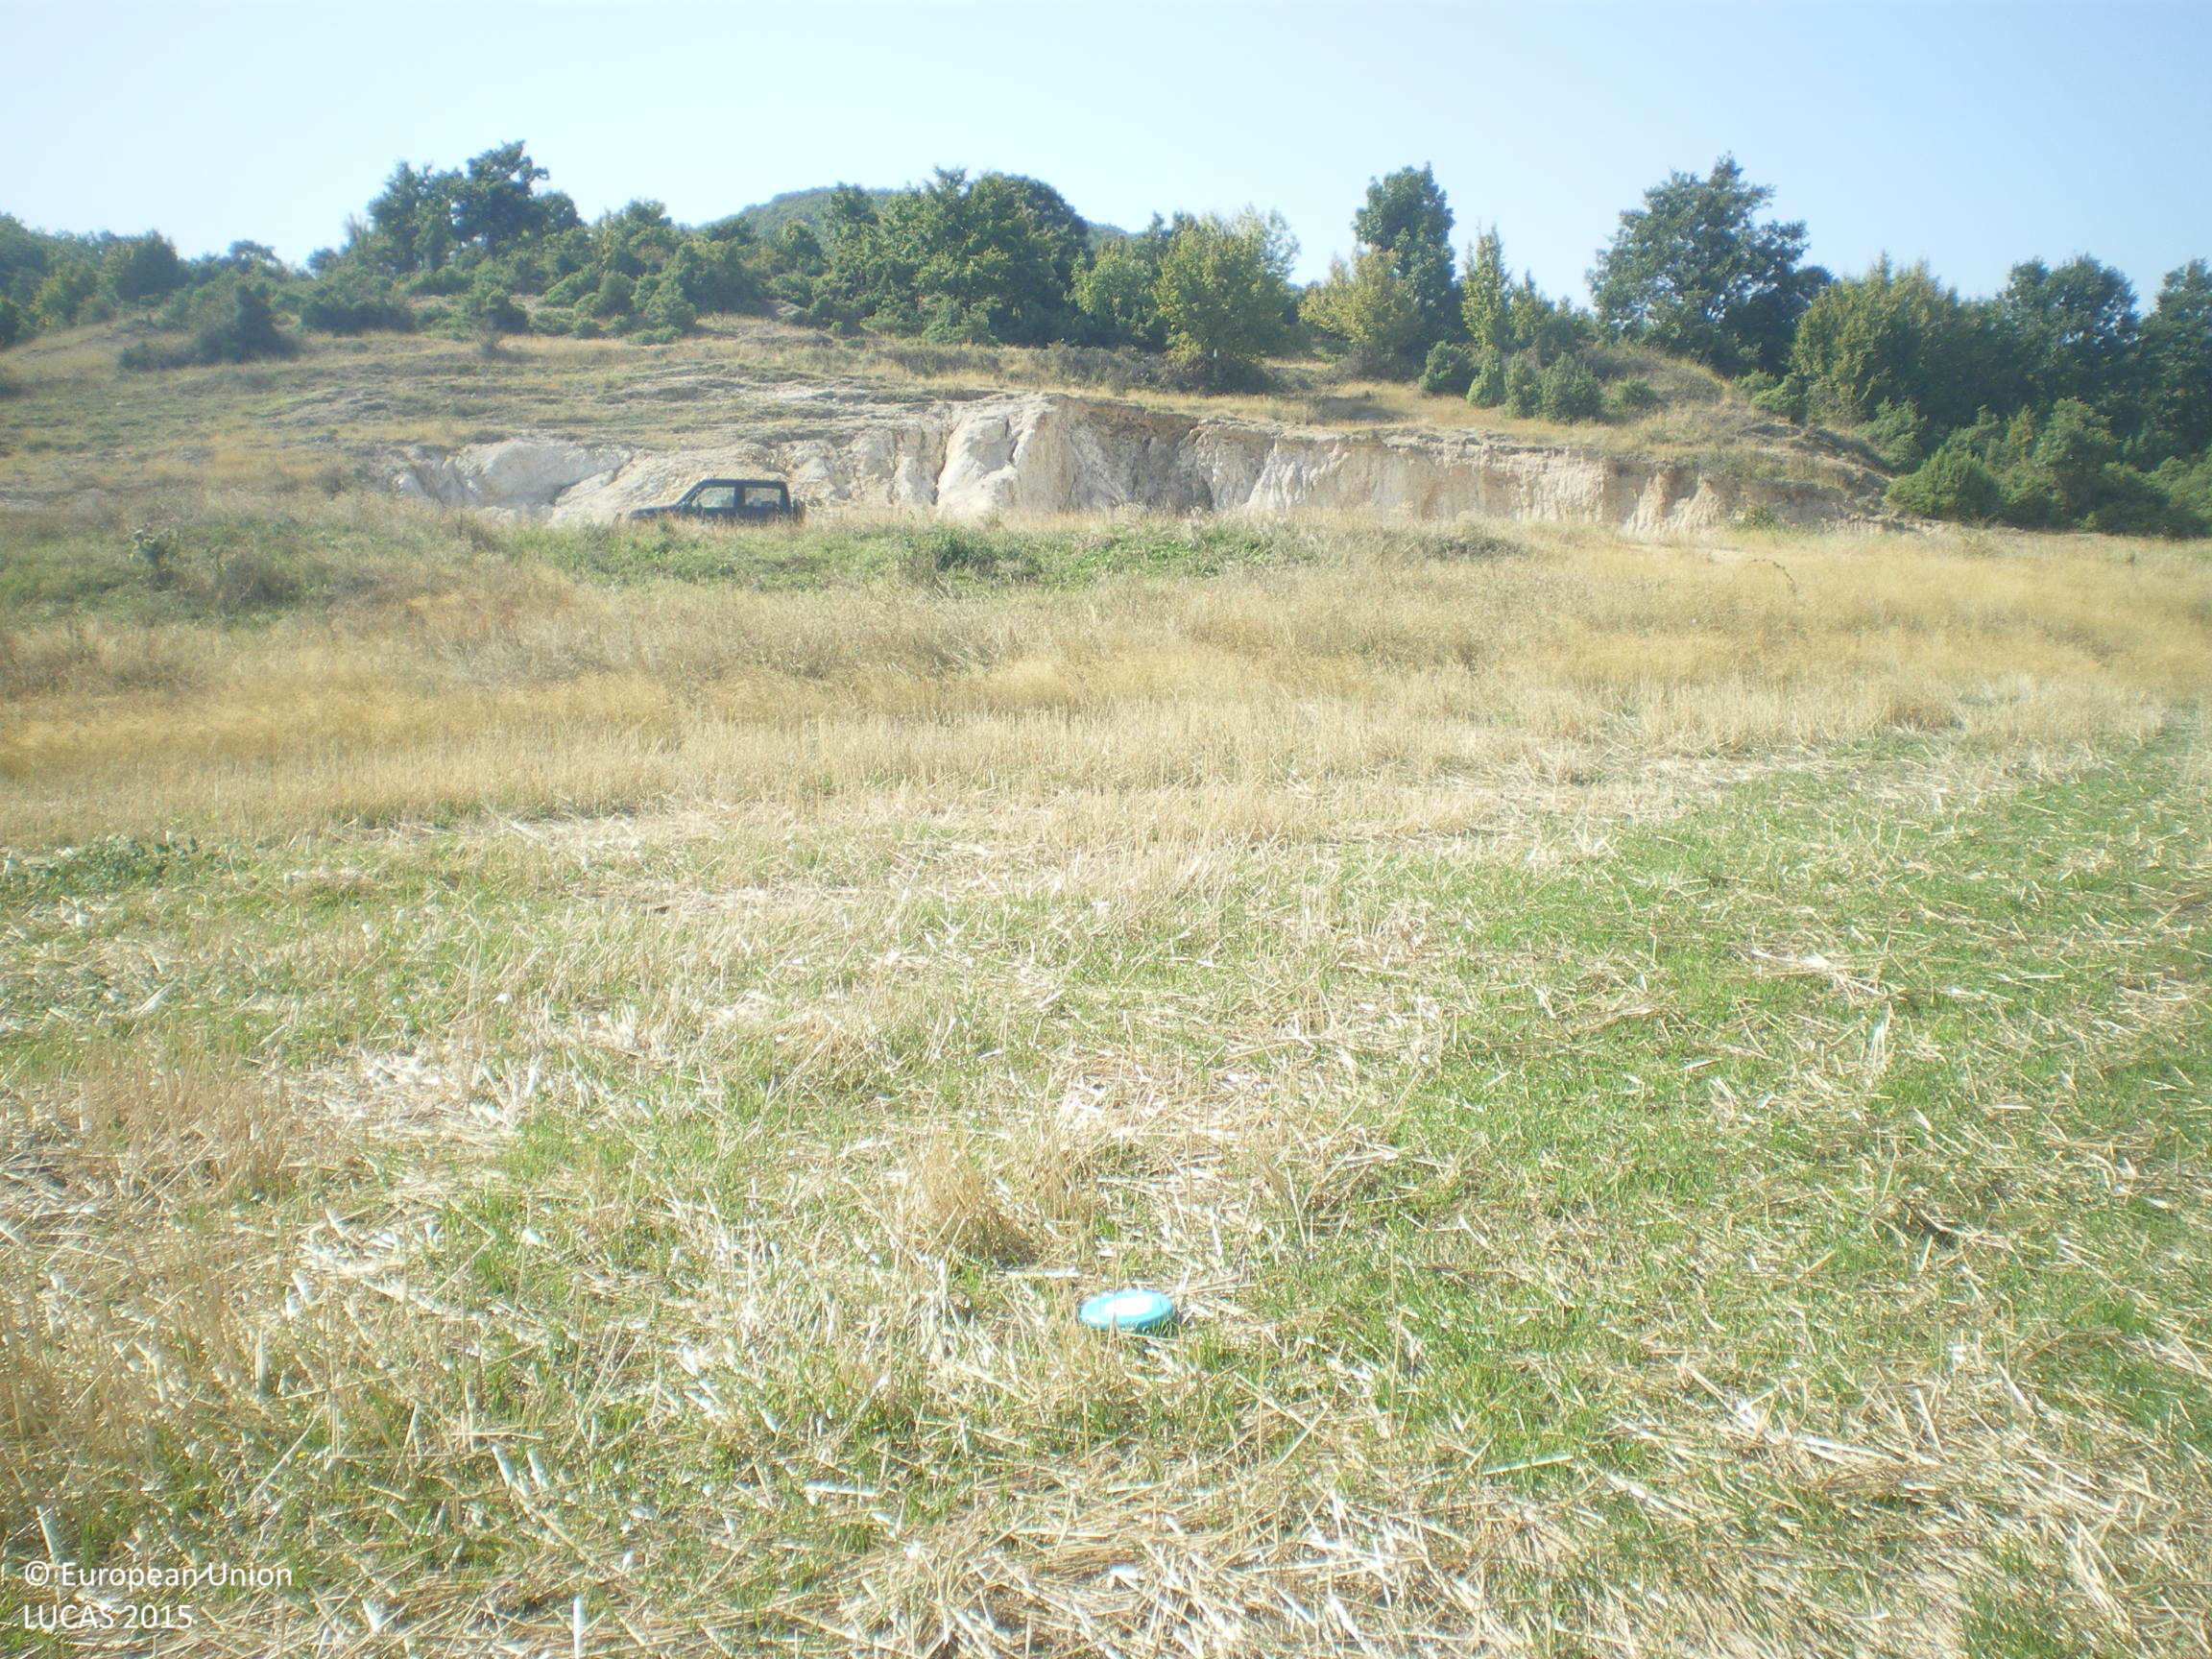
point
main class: Cropland
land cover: Common wheat
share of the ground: 10 - 25 %
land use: Agriculture (excluding fallow land and kitchen gardens)
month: September
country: BG
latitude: 41.7572
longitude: 26.0074
